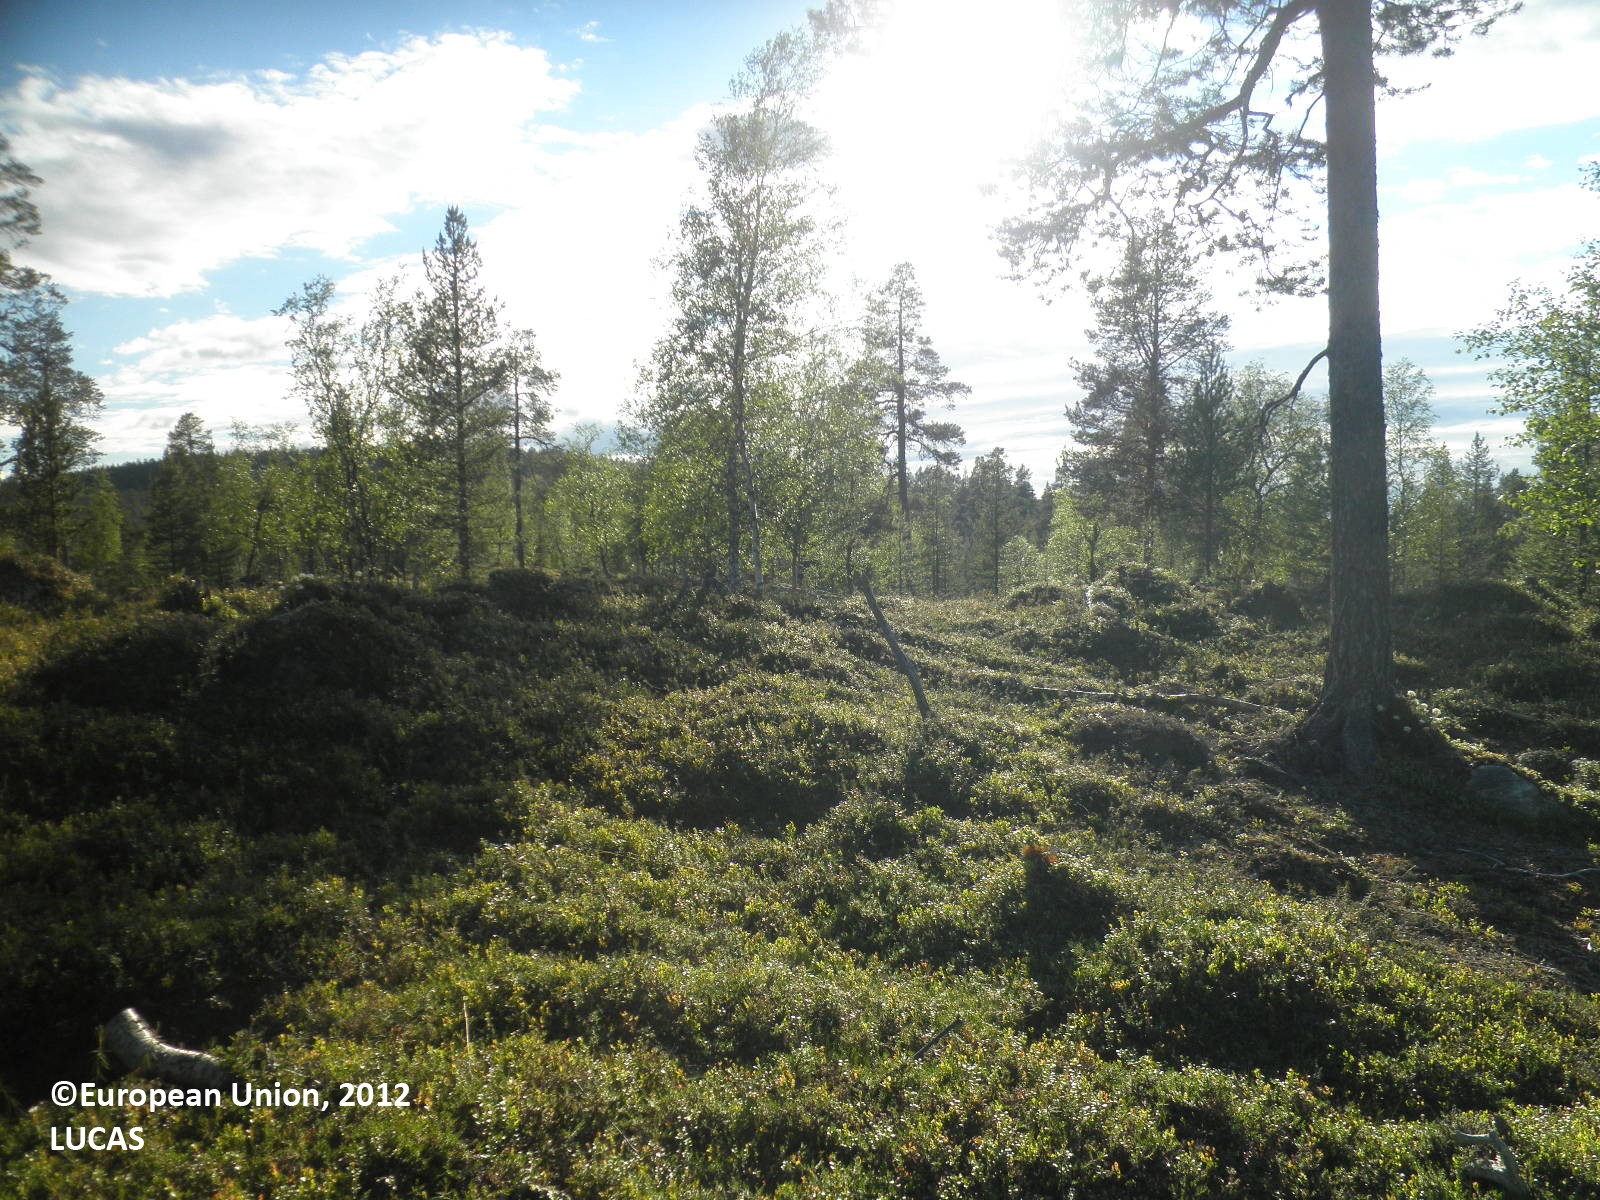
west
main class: Woodland
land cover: Pine dominated mixed woodland
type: boreal forest
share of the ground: 25 - 50 %
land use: Forestry
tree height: > 5 m
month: July
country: FI
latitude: 68.8534
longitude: 27.2295
